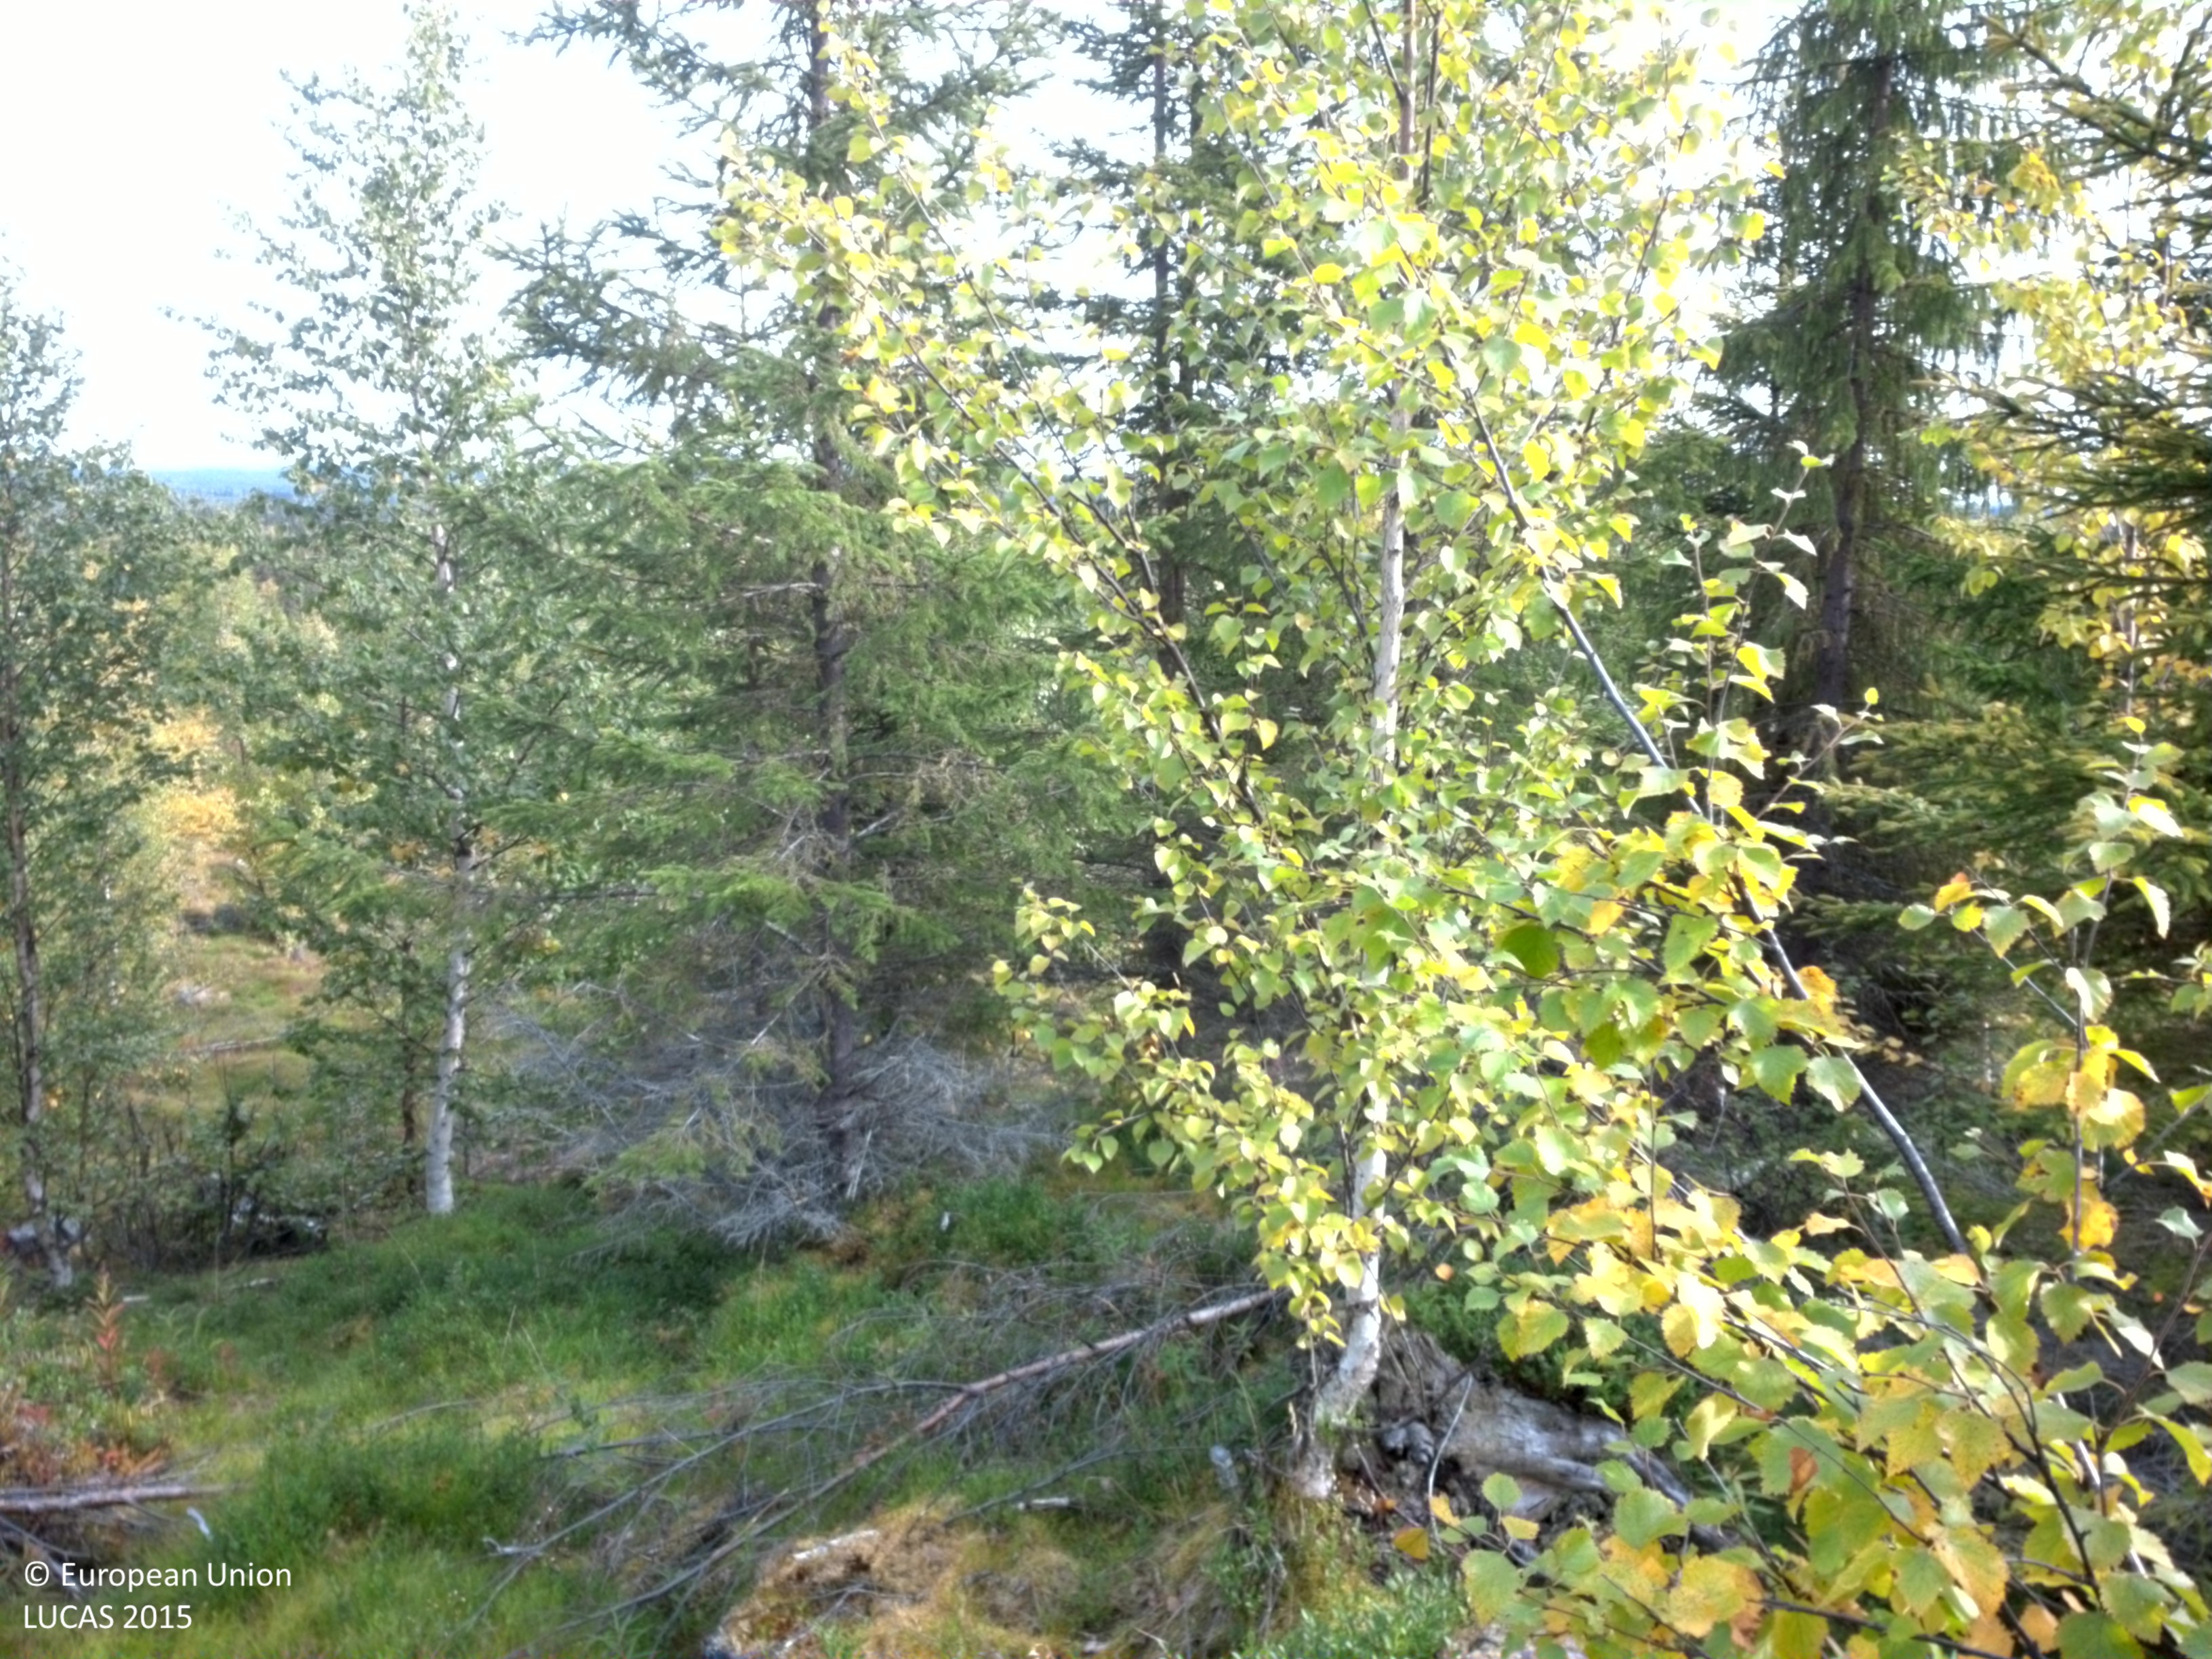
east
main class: Woodland
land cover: Spruce dominated mixed woodland
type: boreal forest
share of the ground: 10 - 25 %
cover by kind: herbaceous plants 35 %, shrubs 25 %, lichens and mosses 20 %, coniferous forest trees 15 %, broadleaved forest trees 5 %
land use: Forestry
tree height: > 5 m
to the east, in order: Spruce dominated mixed woodland; Grassland with sparse tree/shrub cover; Spruce dominated mixed woodland; Grassland with sparse tree/shrub cover; Paved roads, cycling and walking lanes; Grass margins; Spruce dominated mixed woodland; Rivers and streams; Spruce dominated mixed woodland; Shrubland without tree cover; Peatbogs; Shrubland without tree cover
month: September
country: SE
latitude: 65.4011
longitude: 16.6575
